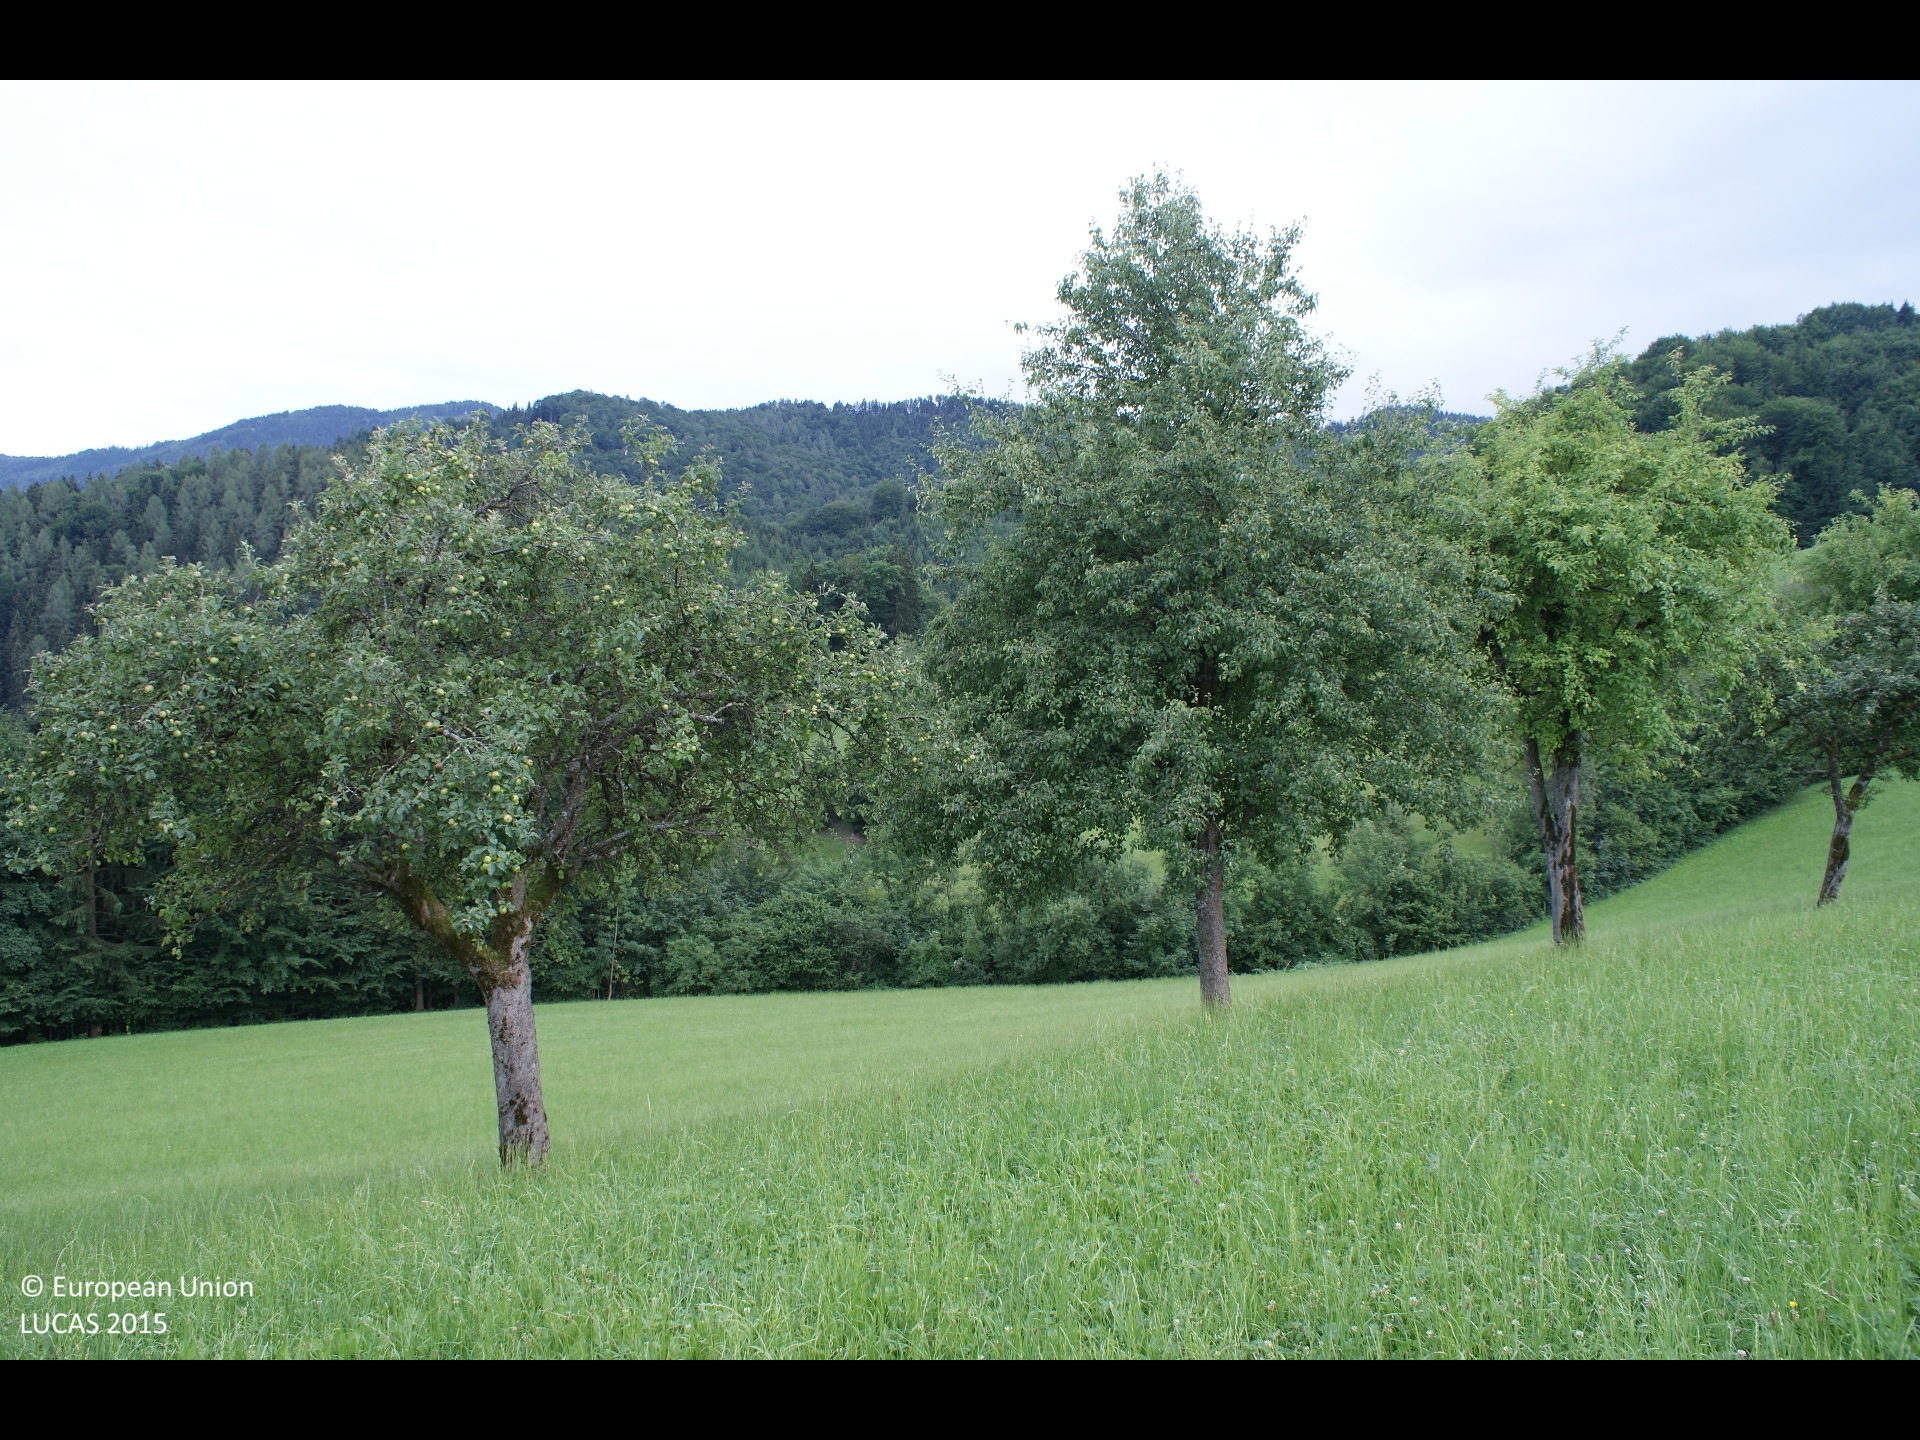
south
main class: Grassland
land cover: Grassland without tree/shrub cover
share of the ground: > 75 %
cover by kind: herbaceous plants 100 %
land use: Agriculture (excluding fallow land and kitchen gardens)
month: July
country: AT
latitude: 47.9469
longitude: 15.0216
